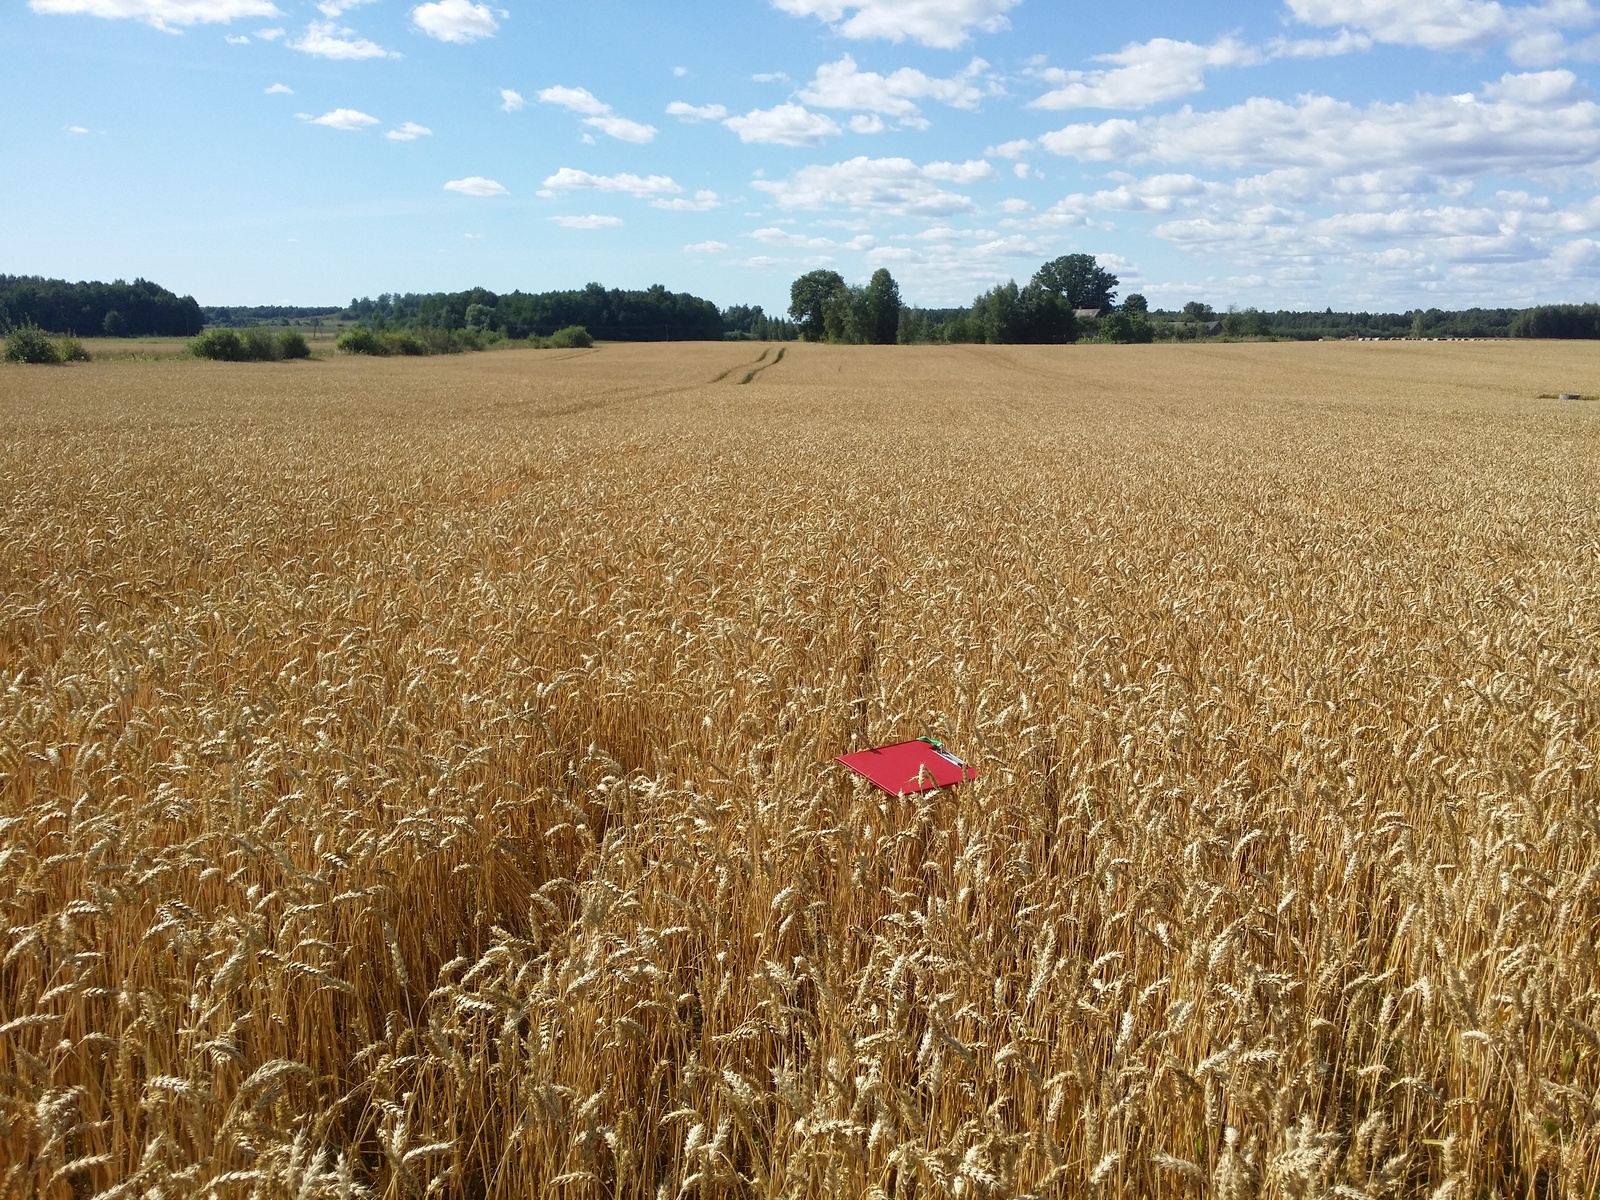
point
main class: Cropland
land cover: Common wheat
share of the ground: > 75 %
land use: Agriculture (excluding fallow land and kitchen gardens)
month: August
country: LV
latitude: 56.9951
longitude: 27.6804
